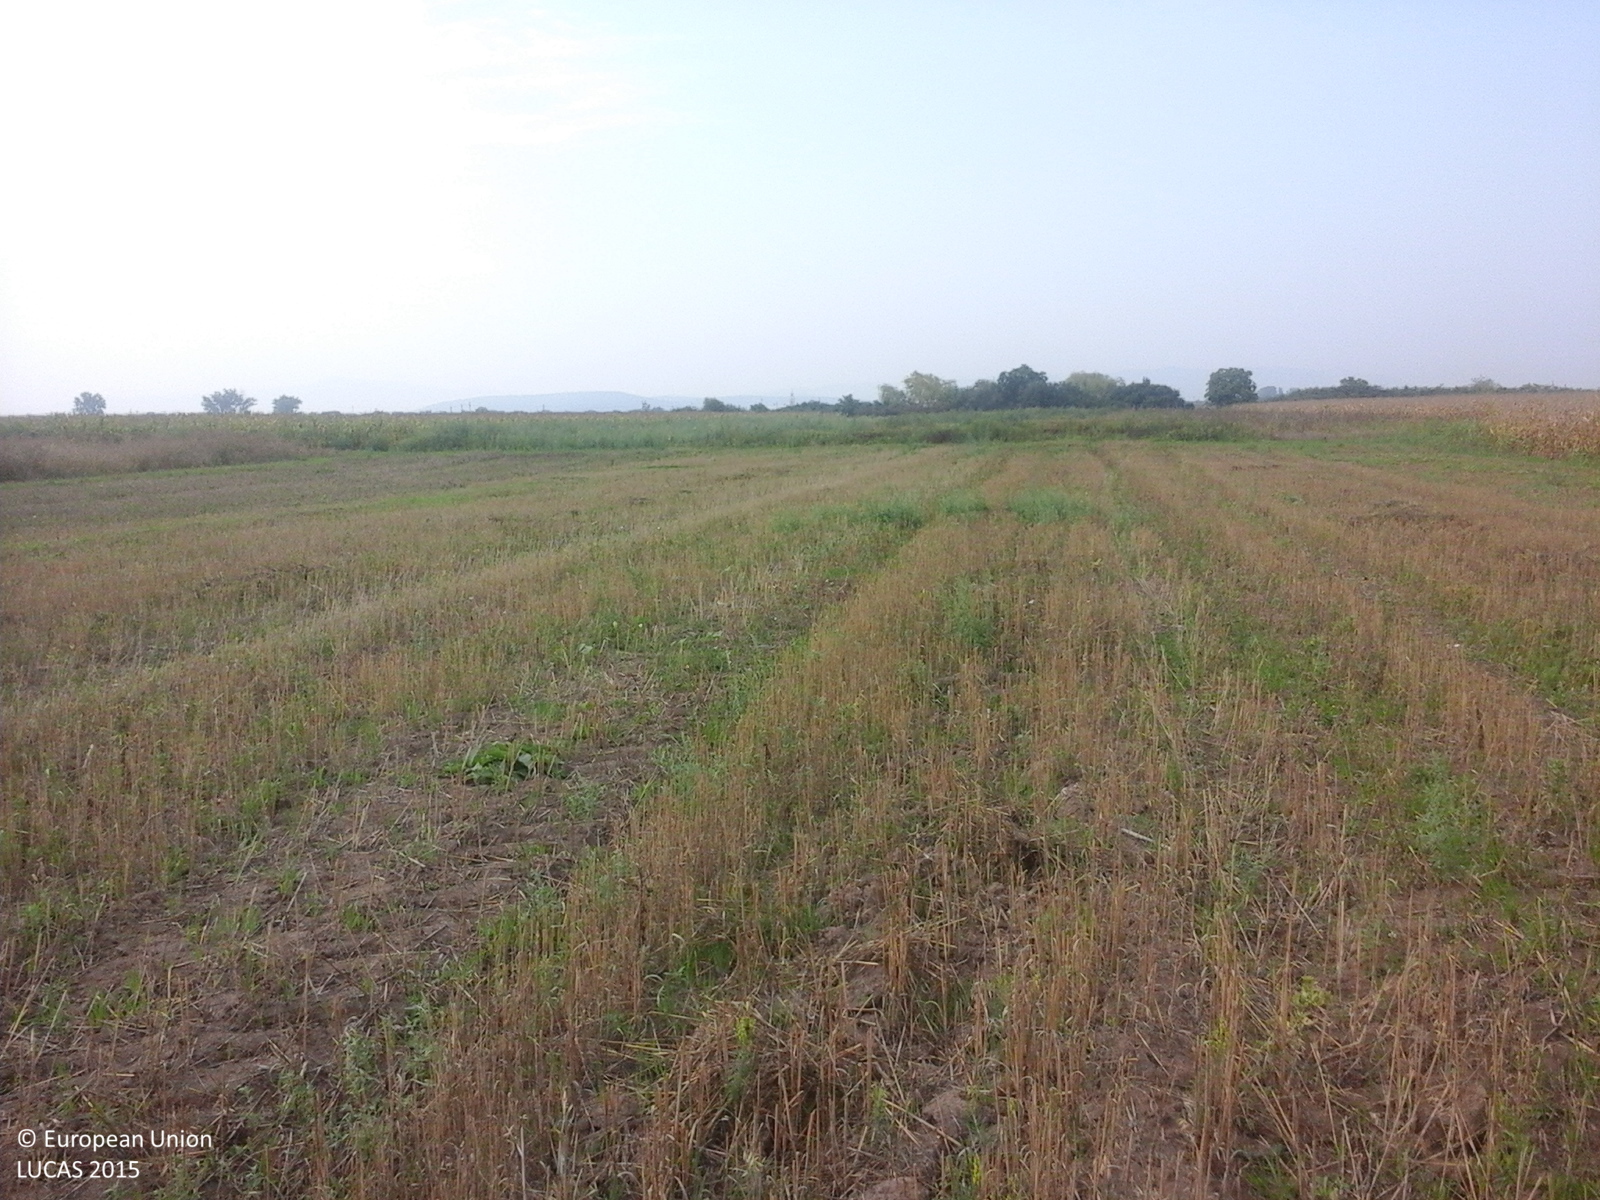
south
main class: Cropland
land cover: Oats
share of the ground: 25 - 50 %
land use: Agriculture (excluding fallow land and kitchen gardens)
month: August
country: RO
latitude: 46.3973
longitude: 21.7061
